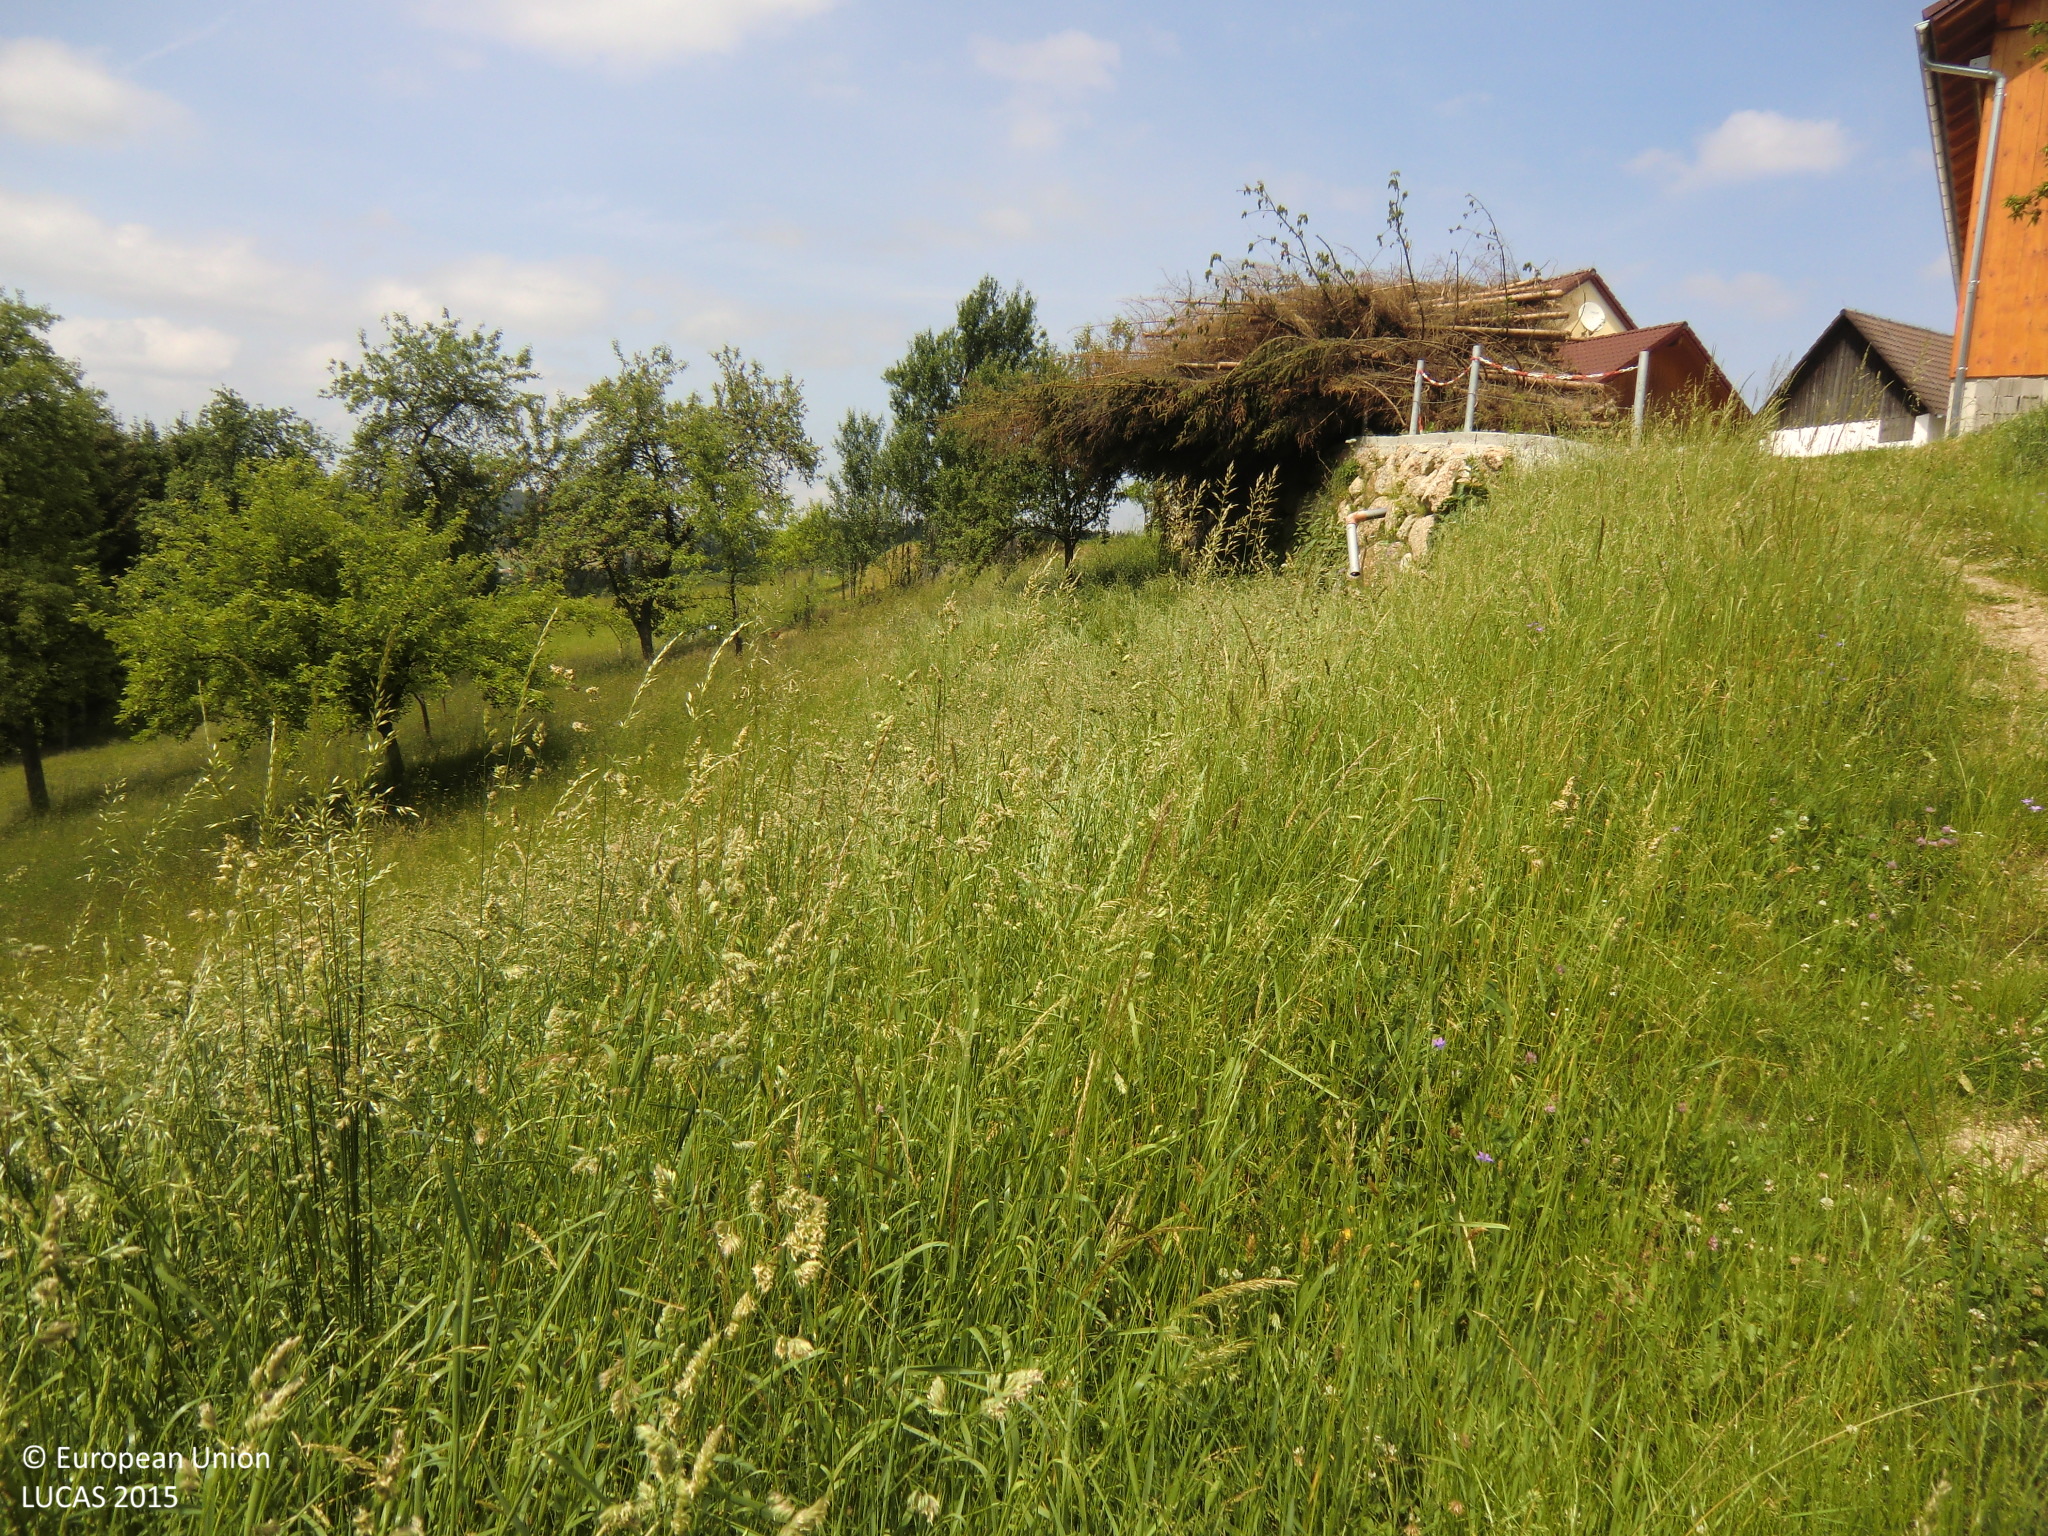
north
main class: Cropland
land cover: Apple fruit
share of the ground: 25 - 50 %
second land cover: Grassland without tree/shrub cover
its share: > 75 %
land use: Agriculture (excluding fallow land and kitchen gardens)
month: June
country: AT
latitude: 48.3717
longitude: 14.7934
